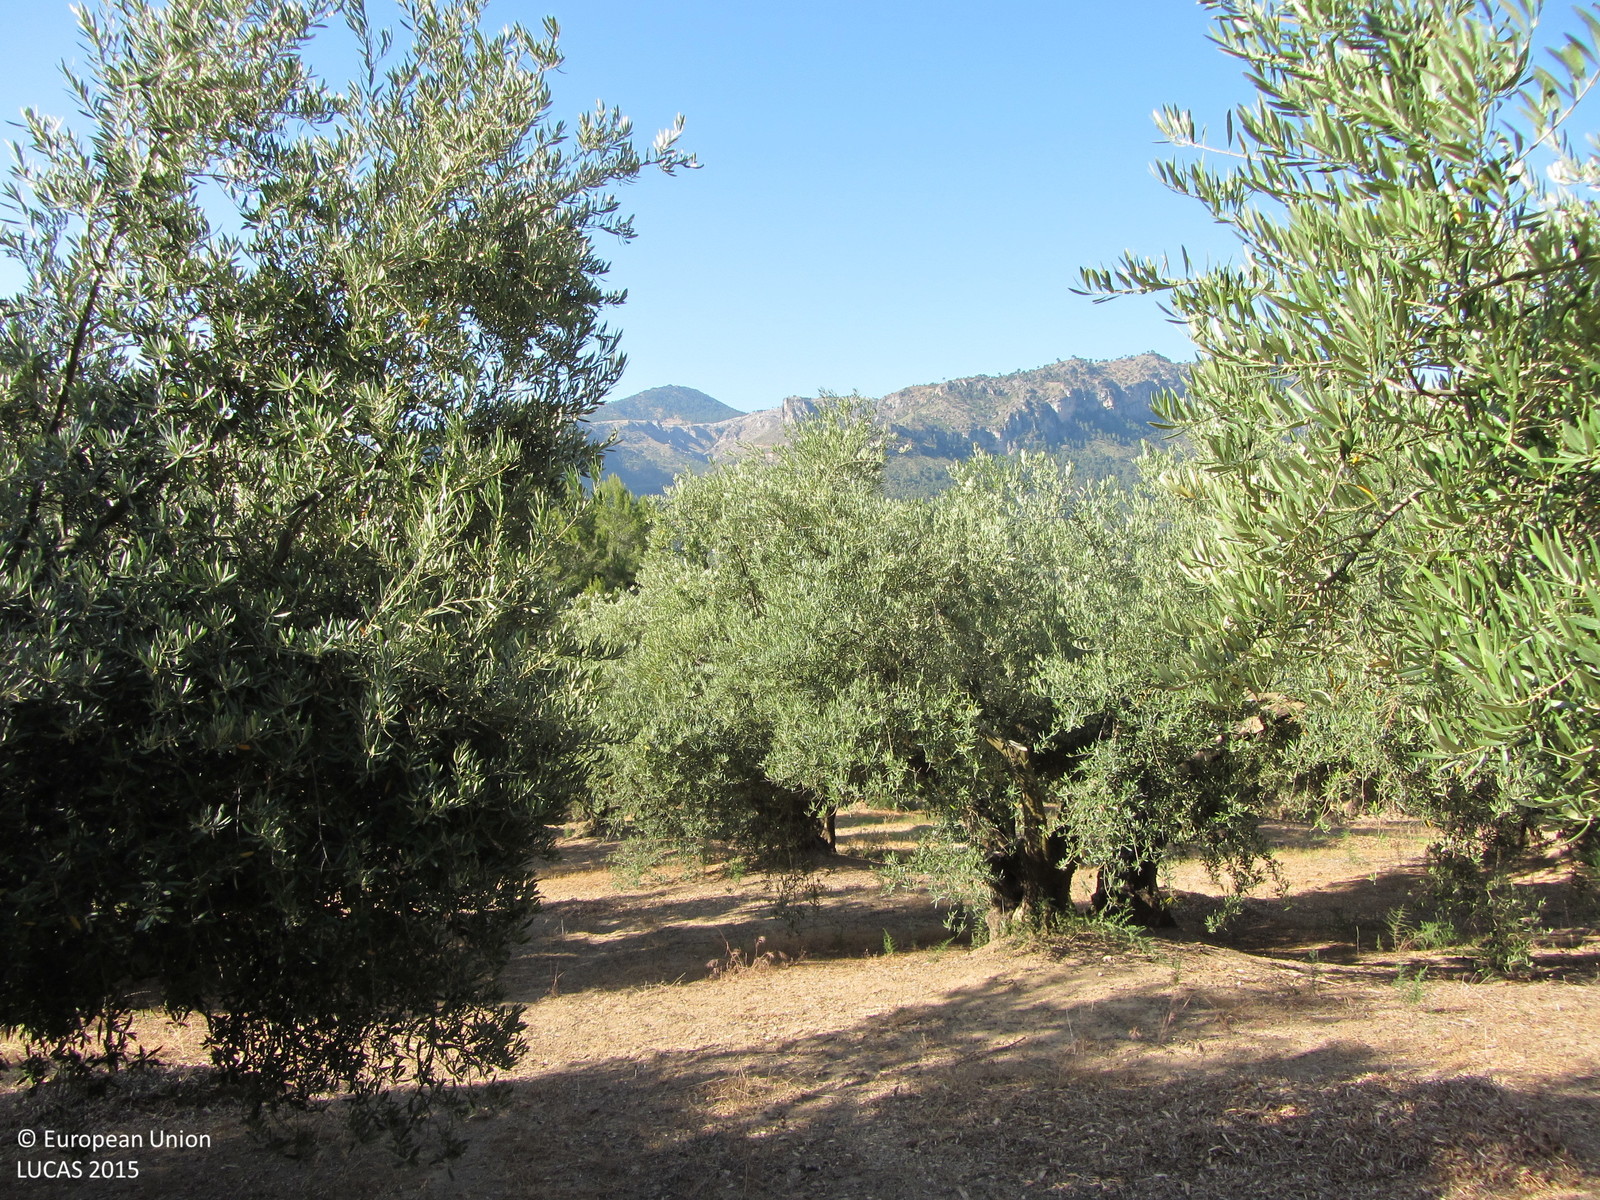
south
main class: Cropland
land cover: Olive groves
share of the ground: 50 - 75 %
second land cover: Other bare soil
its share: > 75 %
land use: Agriculture (excluding fallow land and kitchen gardens)
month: June
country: ES
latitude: 38.1927
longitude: -2.8429
